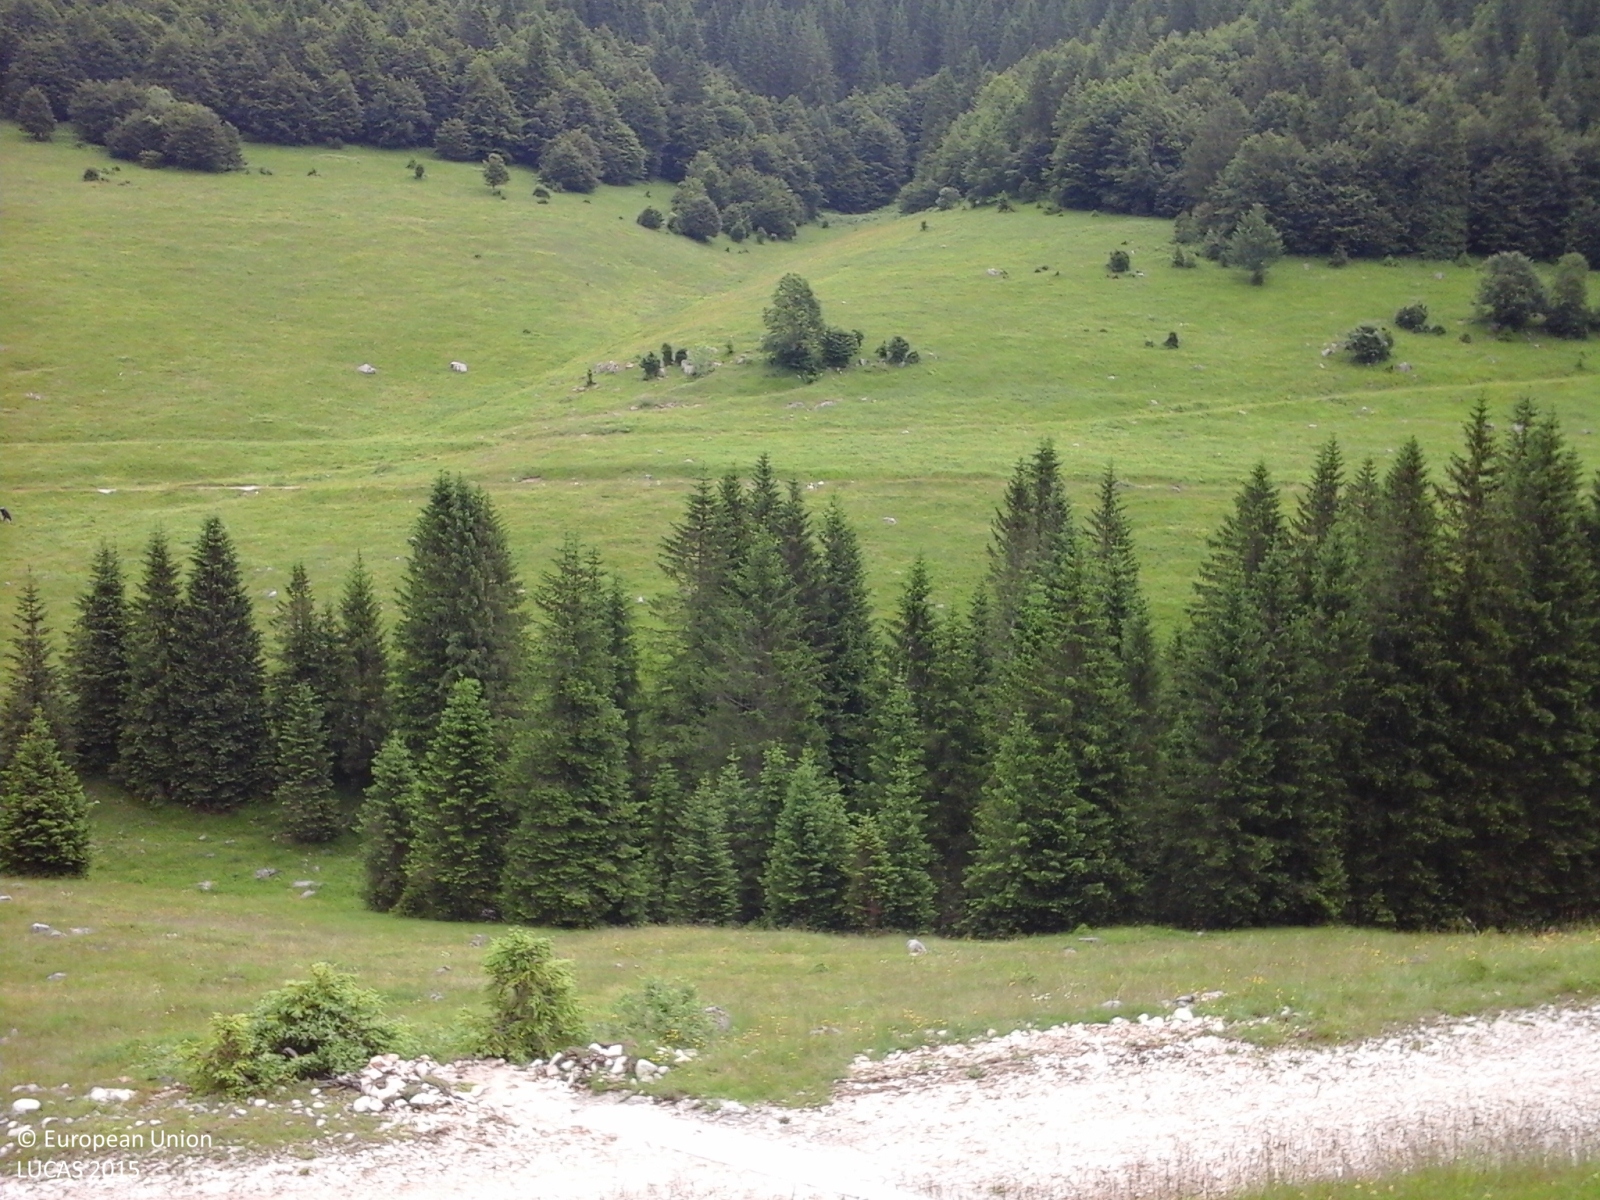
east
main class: Grassland
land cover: Grassland without tree/shrub cover
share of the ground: > 75 %
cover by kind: herbaceous plants 100 %
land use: Agriculture (excluding fallow land and kitchen gardens)
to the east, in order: Grassland without tree/shrub cover; Paved roads, cycling and walking lanes; Grassland without tree/shrub cover; Spruce dominated coniferous woodland; Grassland without tree/shrub cover; Paved roads, cycling and walking lanes; Grassland without tree/shrub cover; Shrubland with sparse tree cover; Grassland without tree/shrub cover
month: June
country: IT
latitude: 45.9423
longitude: 11.6358
